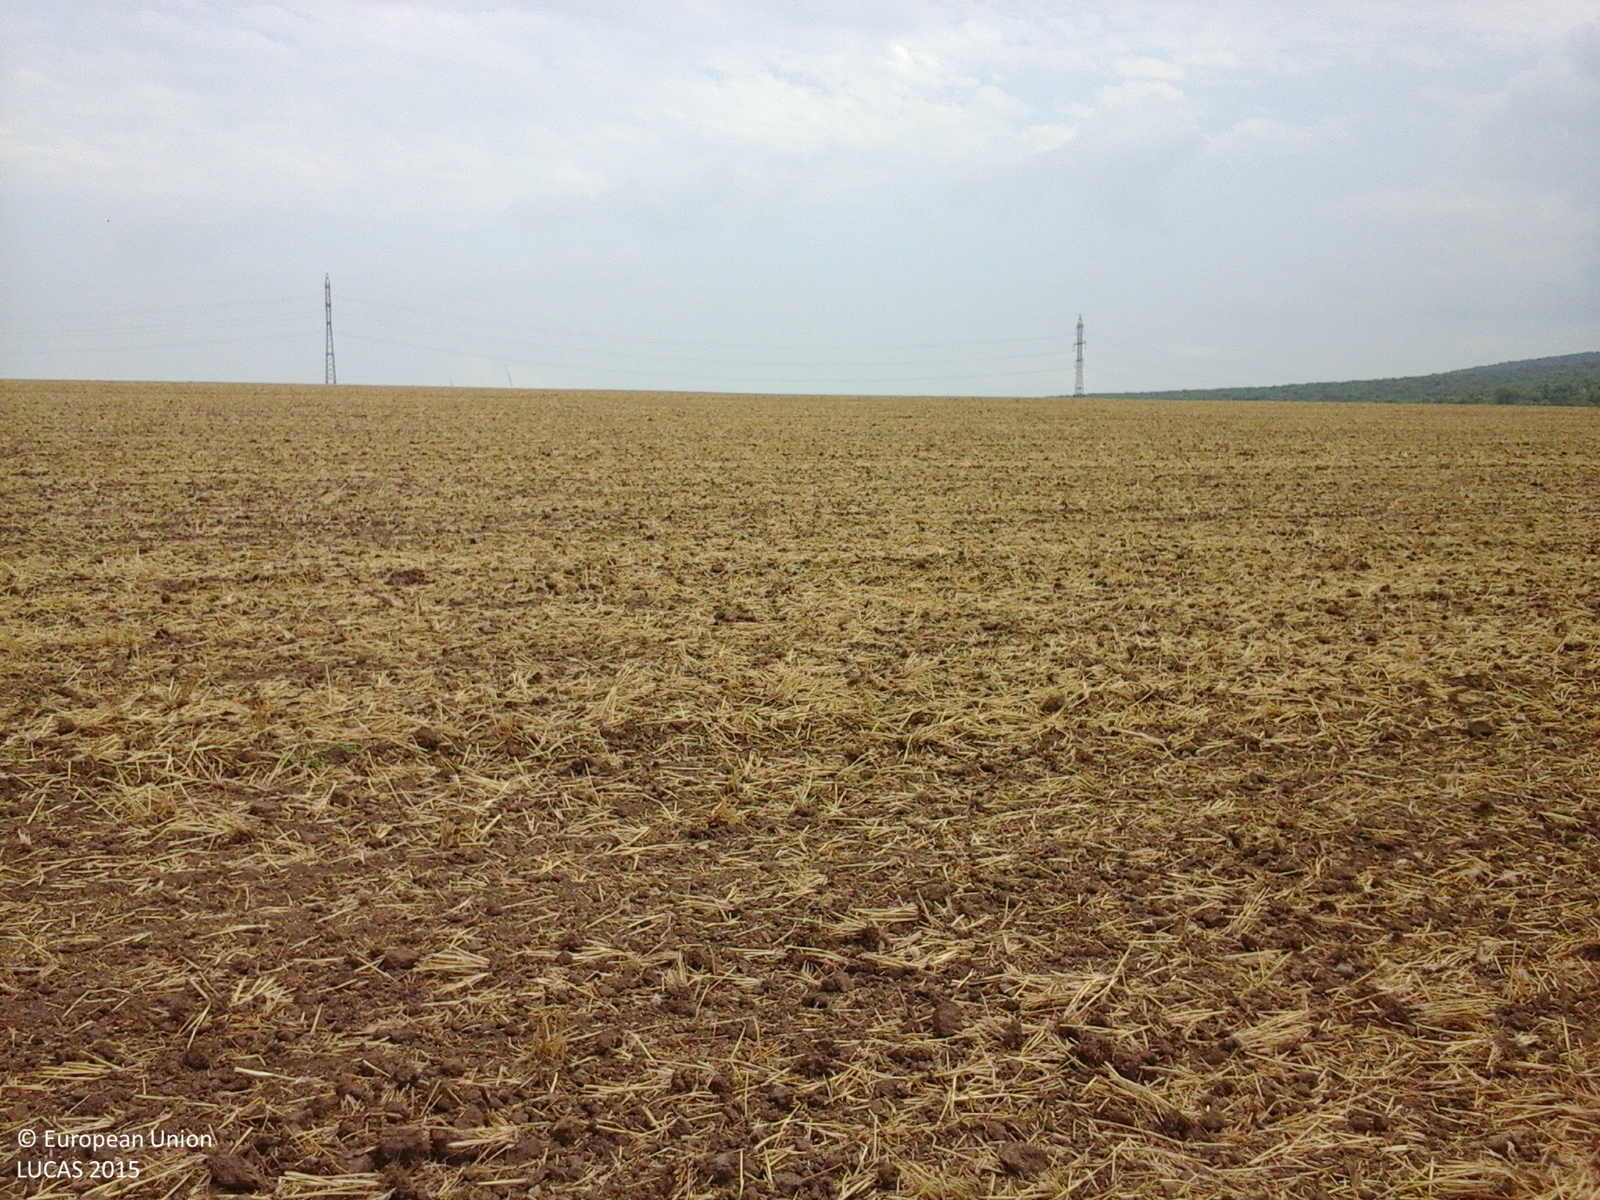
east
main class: Cropland
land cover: Durum wheat
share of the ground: < 10 %
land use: Agriculture (excluding fallow land and kitchen gardens)
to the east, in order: Durum wheat
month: July
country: RO
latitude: 44.9024
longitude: 28.6088
